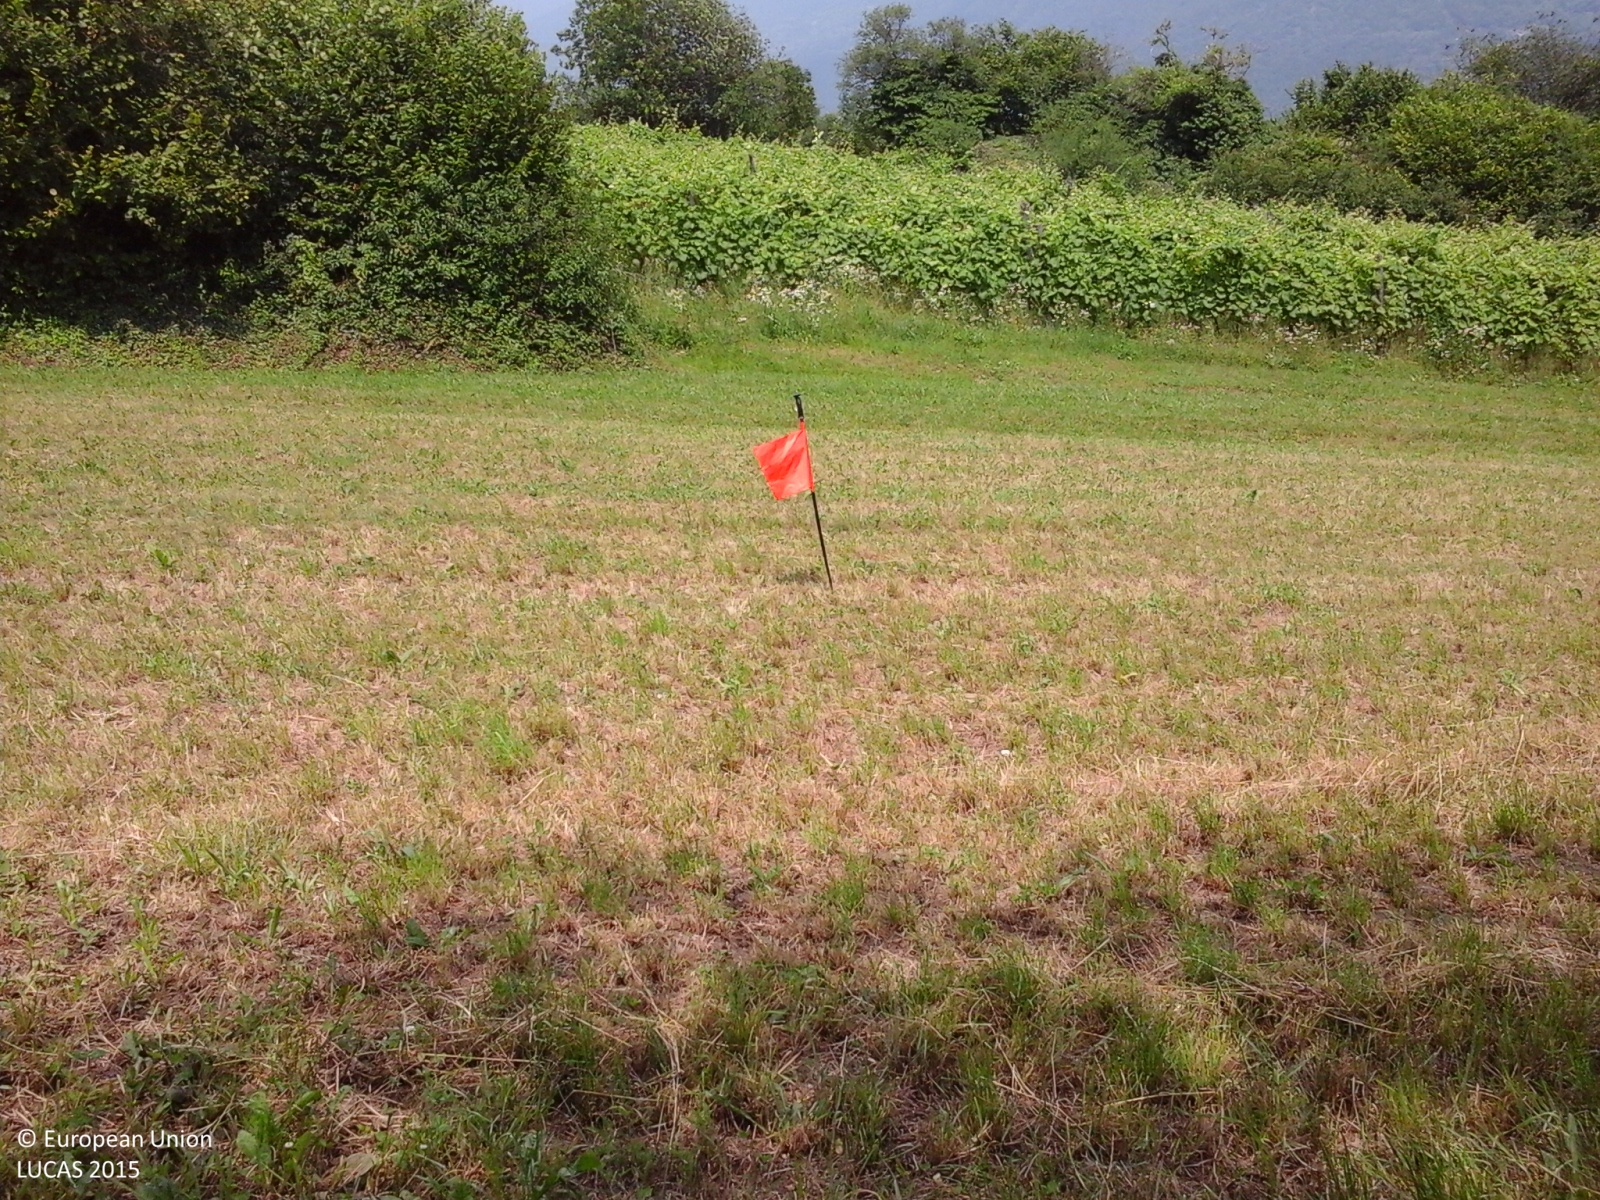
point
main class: Grassland
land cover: Grassland without tree/shrub cover
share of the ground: > 75 %
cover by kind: herbaceous plants 100 %
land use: Agriculture (excluding fallow land and kitchen gardens)
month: July
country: IT
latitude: 45.9904
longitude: 10.3223
